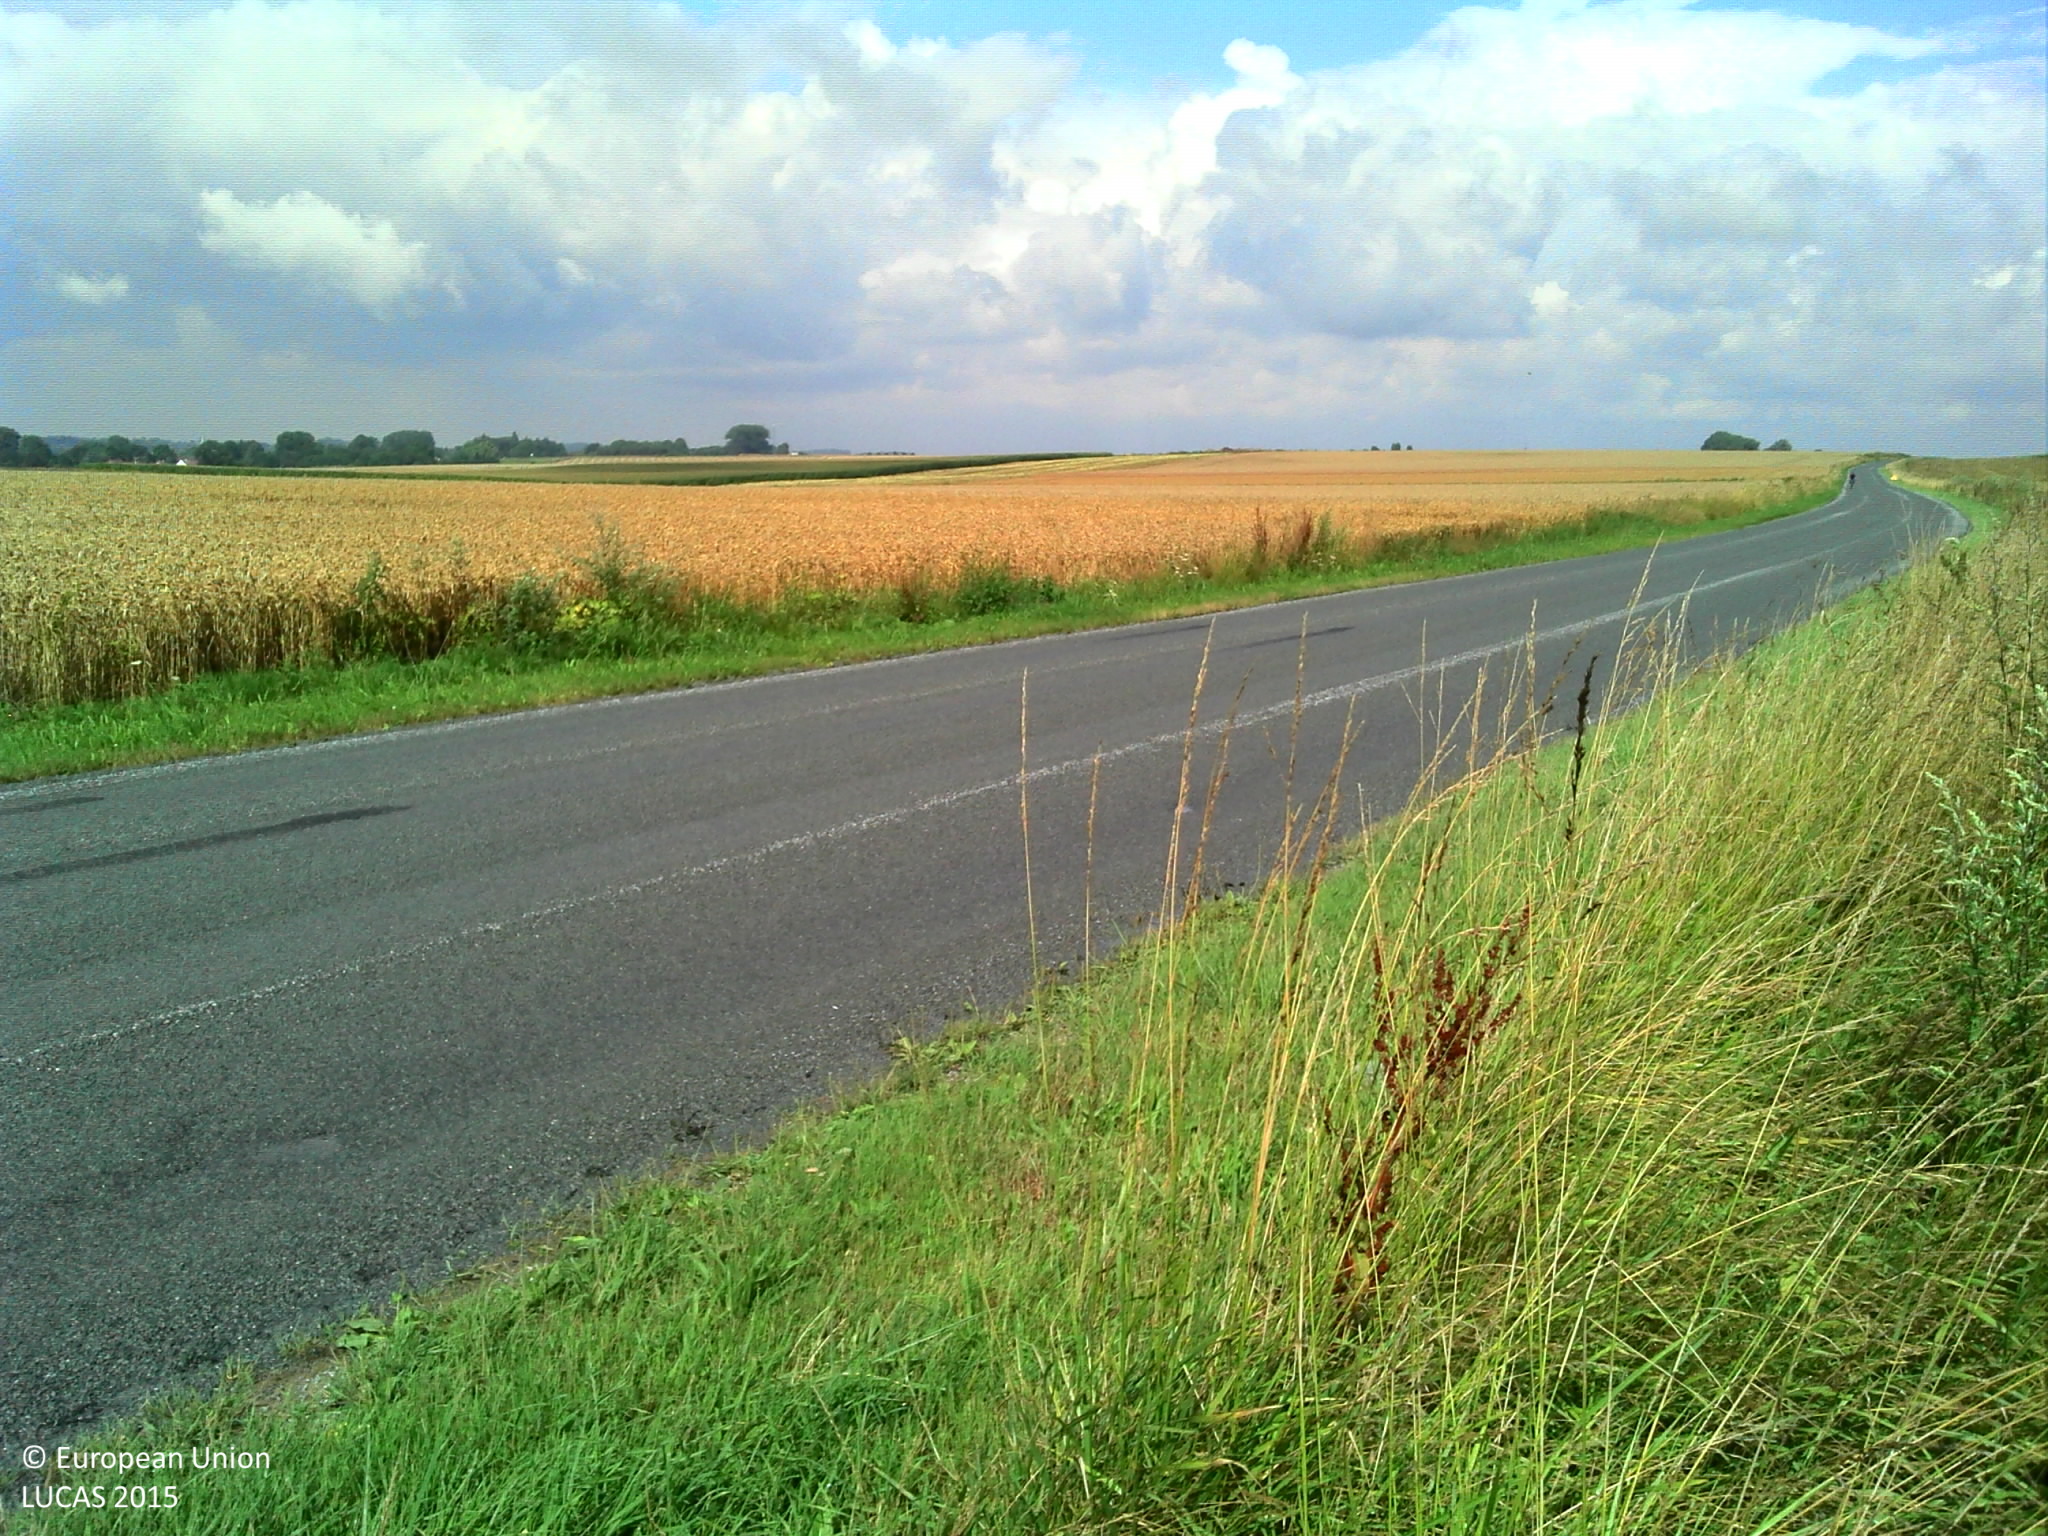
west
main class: Grassland
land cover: Grassland without tree/shrub cover
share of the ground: > 75 %
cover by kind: herbaceous plants 100 %
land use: Agriculture (excluding fallow land and kitchen gardens)
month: July
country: FR
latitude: 50.2934
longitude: 3.6060
